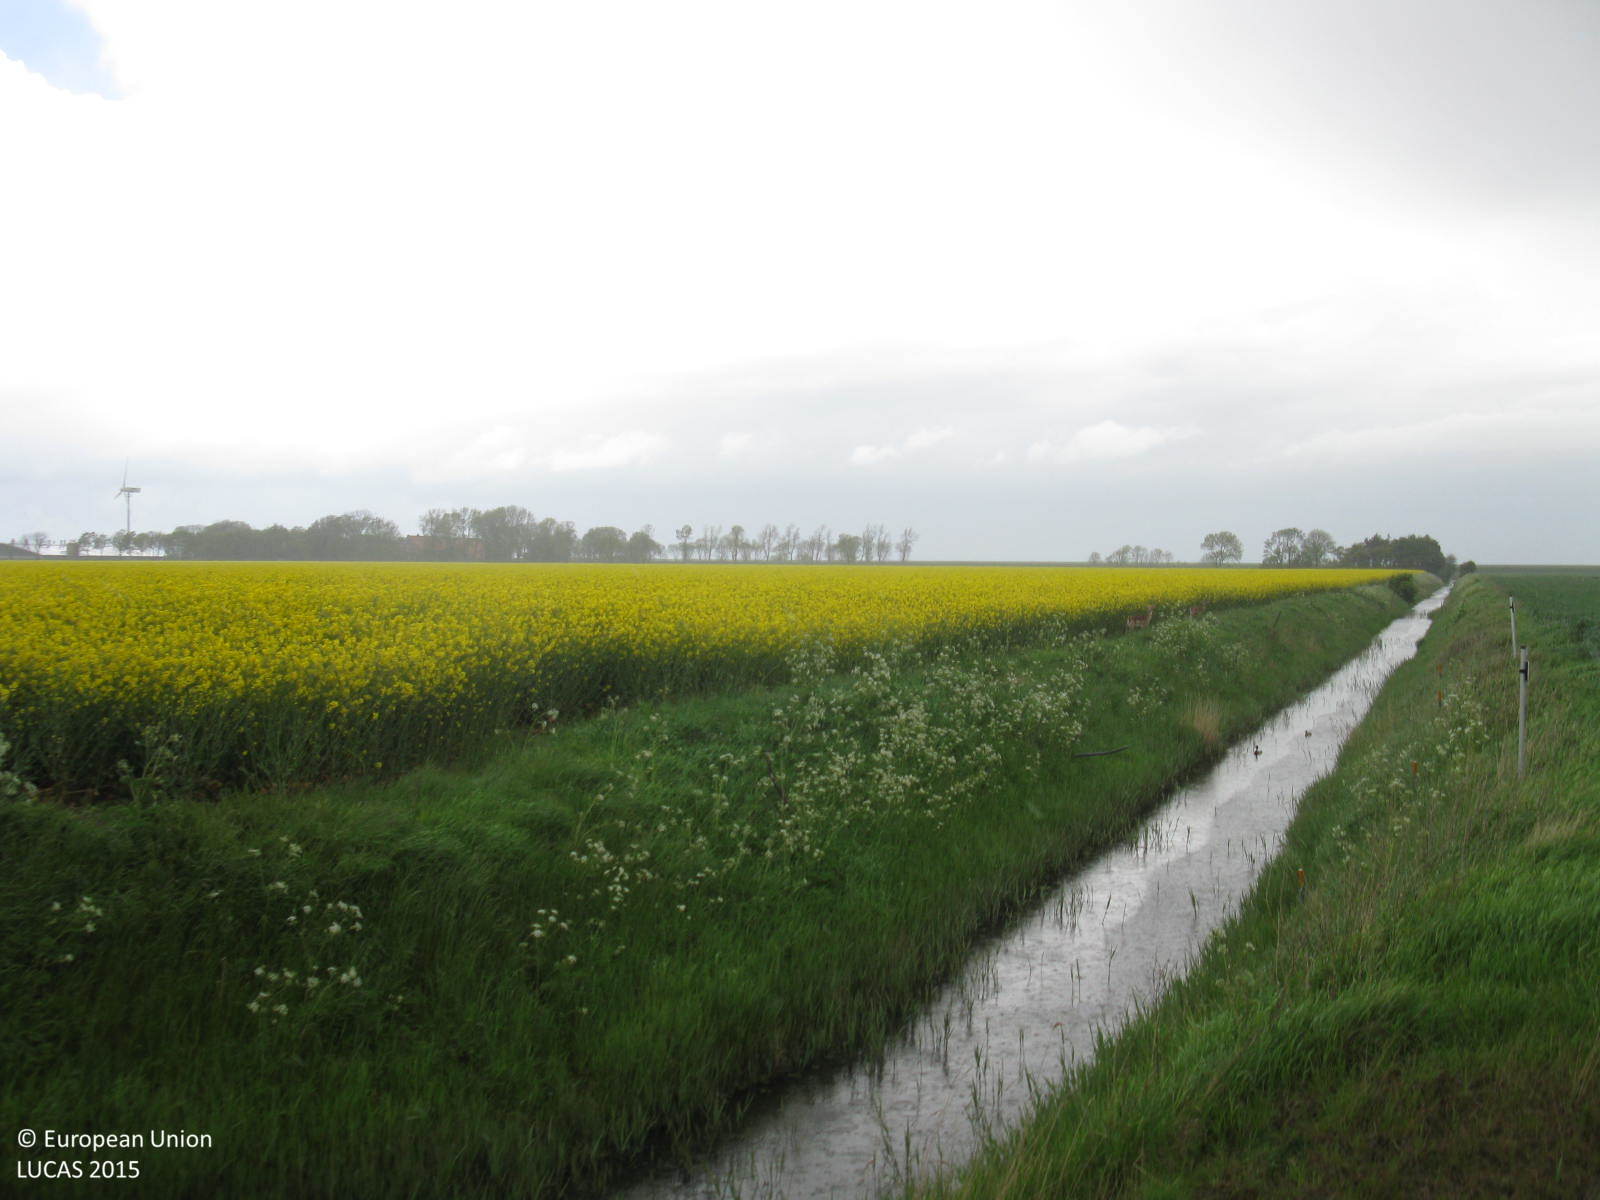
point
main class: Cropland
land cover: Rape and turnip rape
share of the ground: > 75 %
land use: Agriculture (excluding fallow land and kitchen gardens)
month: May
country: DE
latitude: 53.6587
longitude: 7.2618
